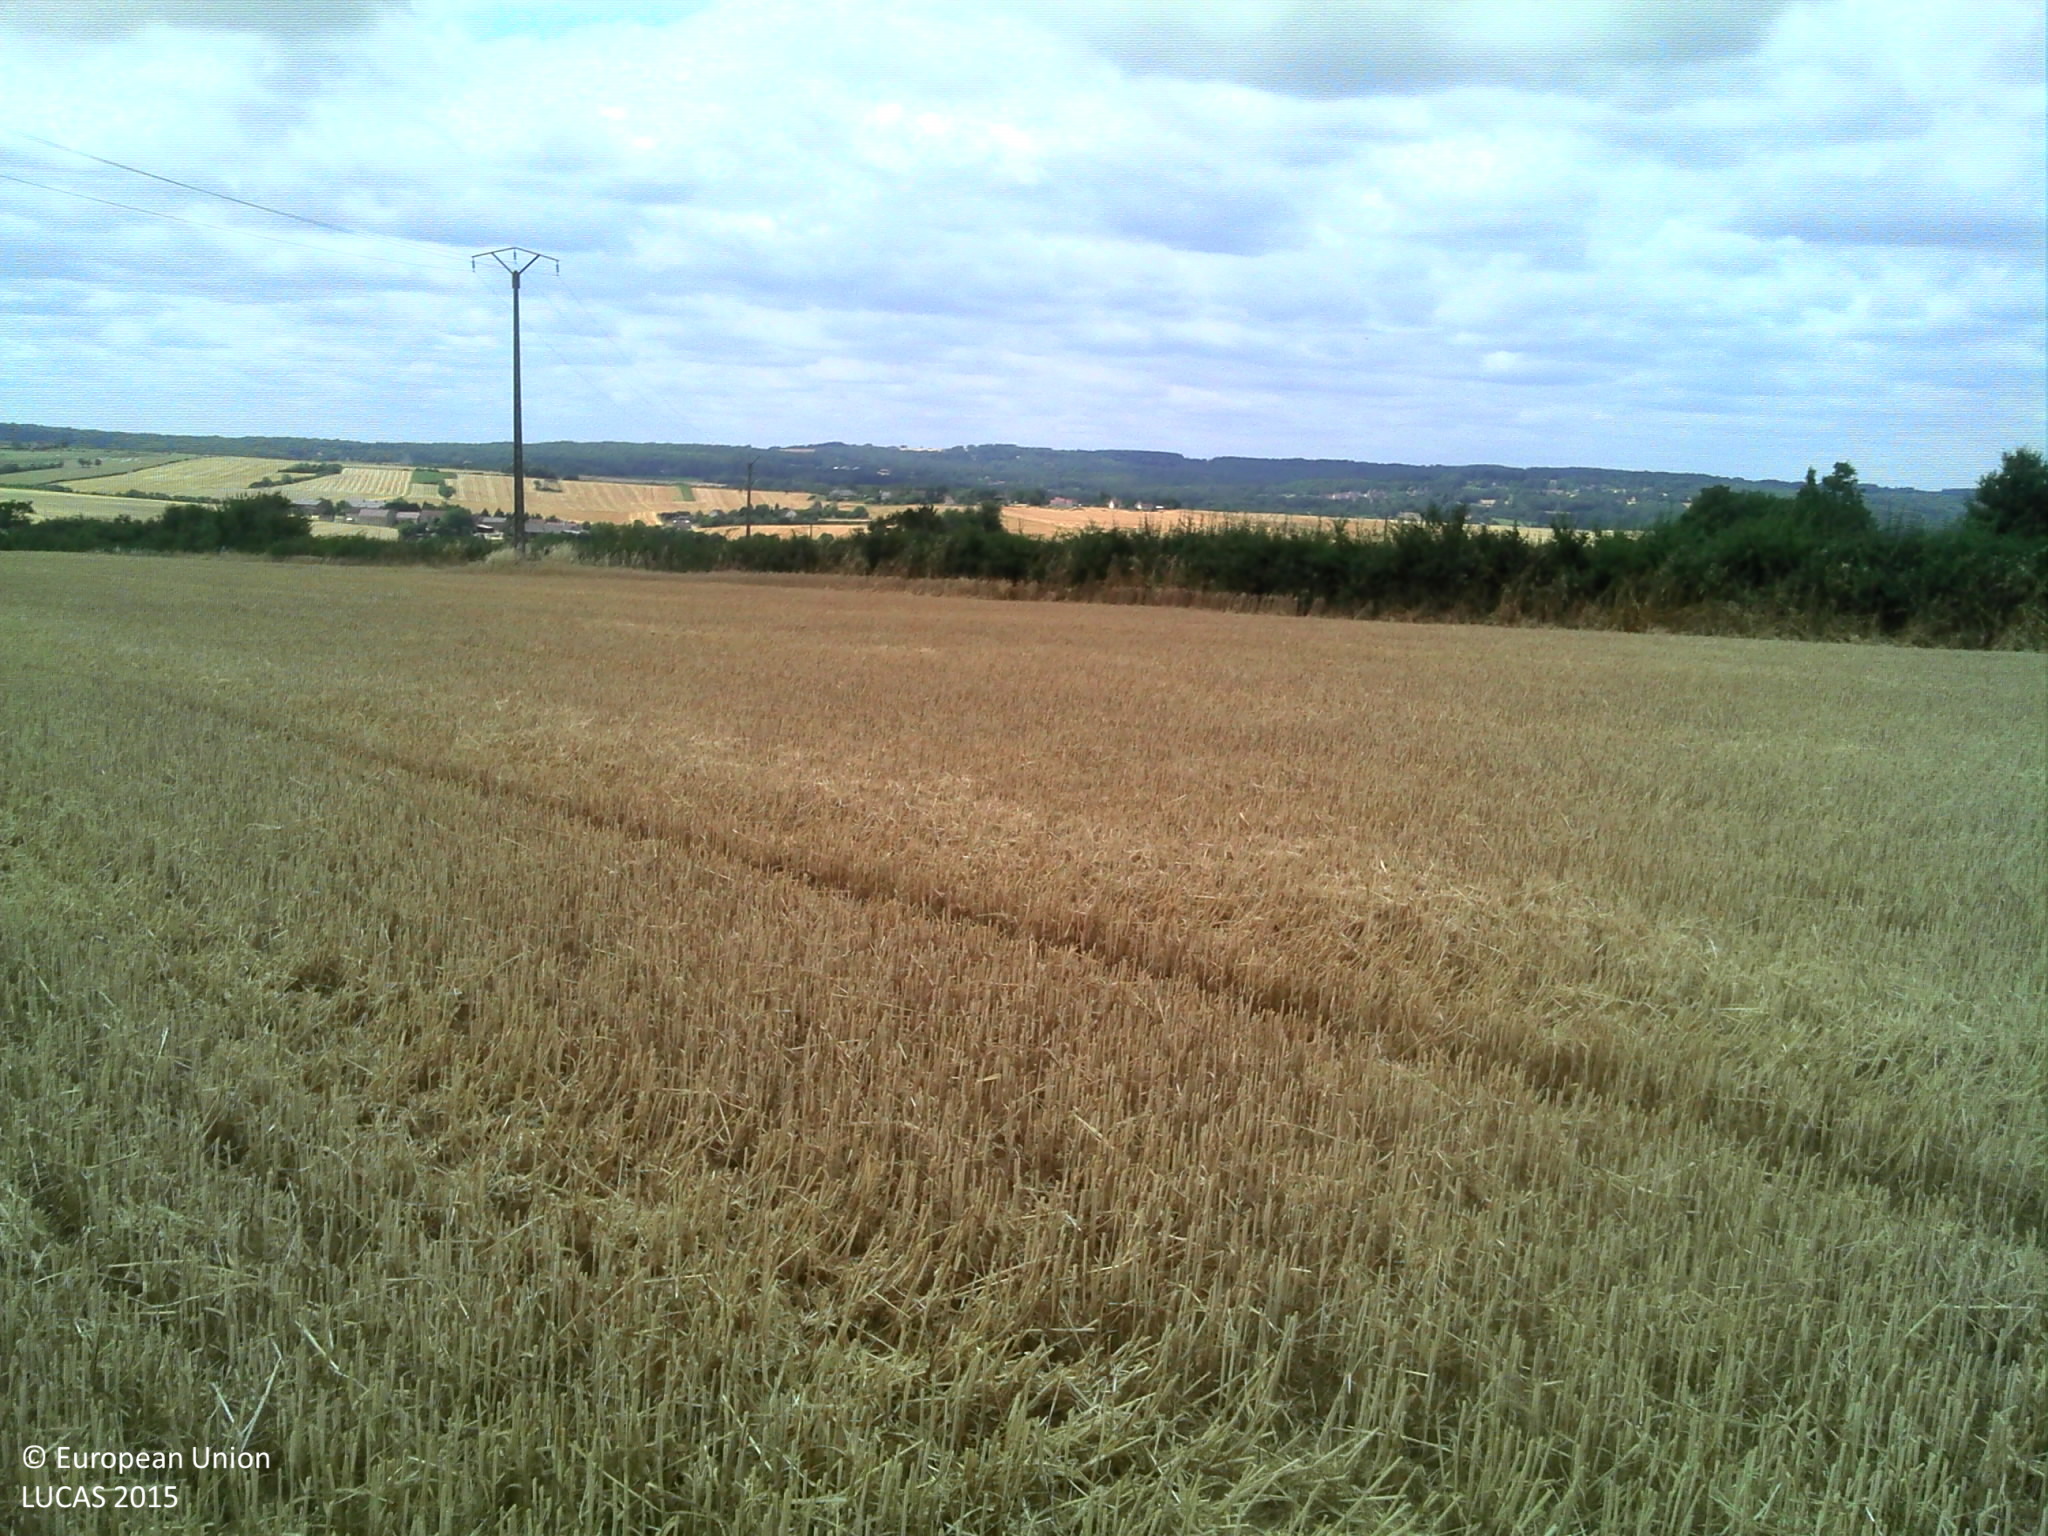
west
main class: Cropland
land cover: Common wheat
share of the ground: > 75 %
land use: Agriculture (excluding fallow land and kitchen gardens)
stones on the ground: 10 - 25 %
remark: Harvested field
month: July
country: FR
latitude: 47.7218
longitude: 3.4498
